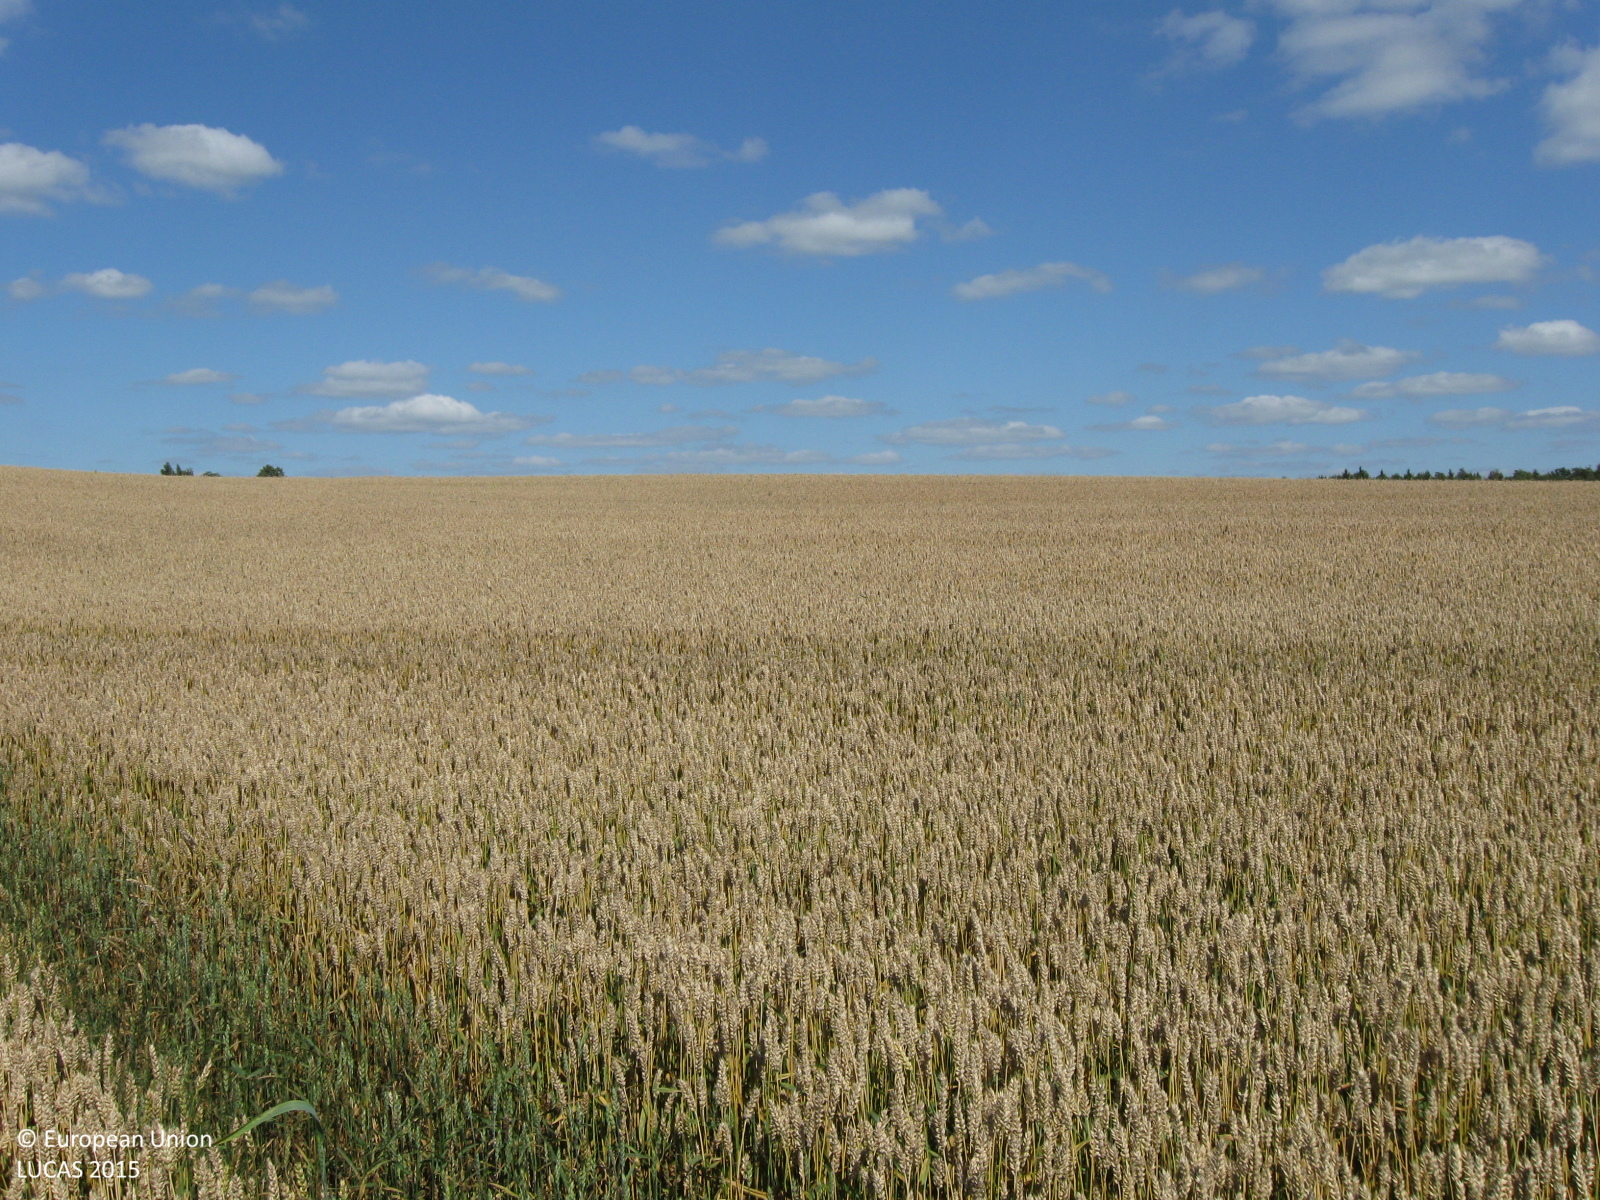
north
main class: Cropland
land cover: Common wheat
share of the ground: > 75 %
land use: Agriculture (excluding fallow land and kitchen gardens)
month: August
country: LT
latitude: 55.5215
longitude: 22.6558
